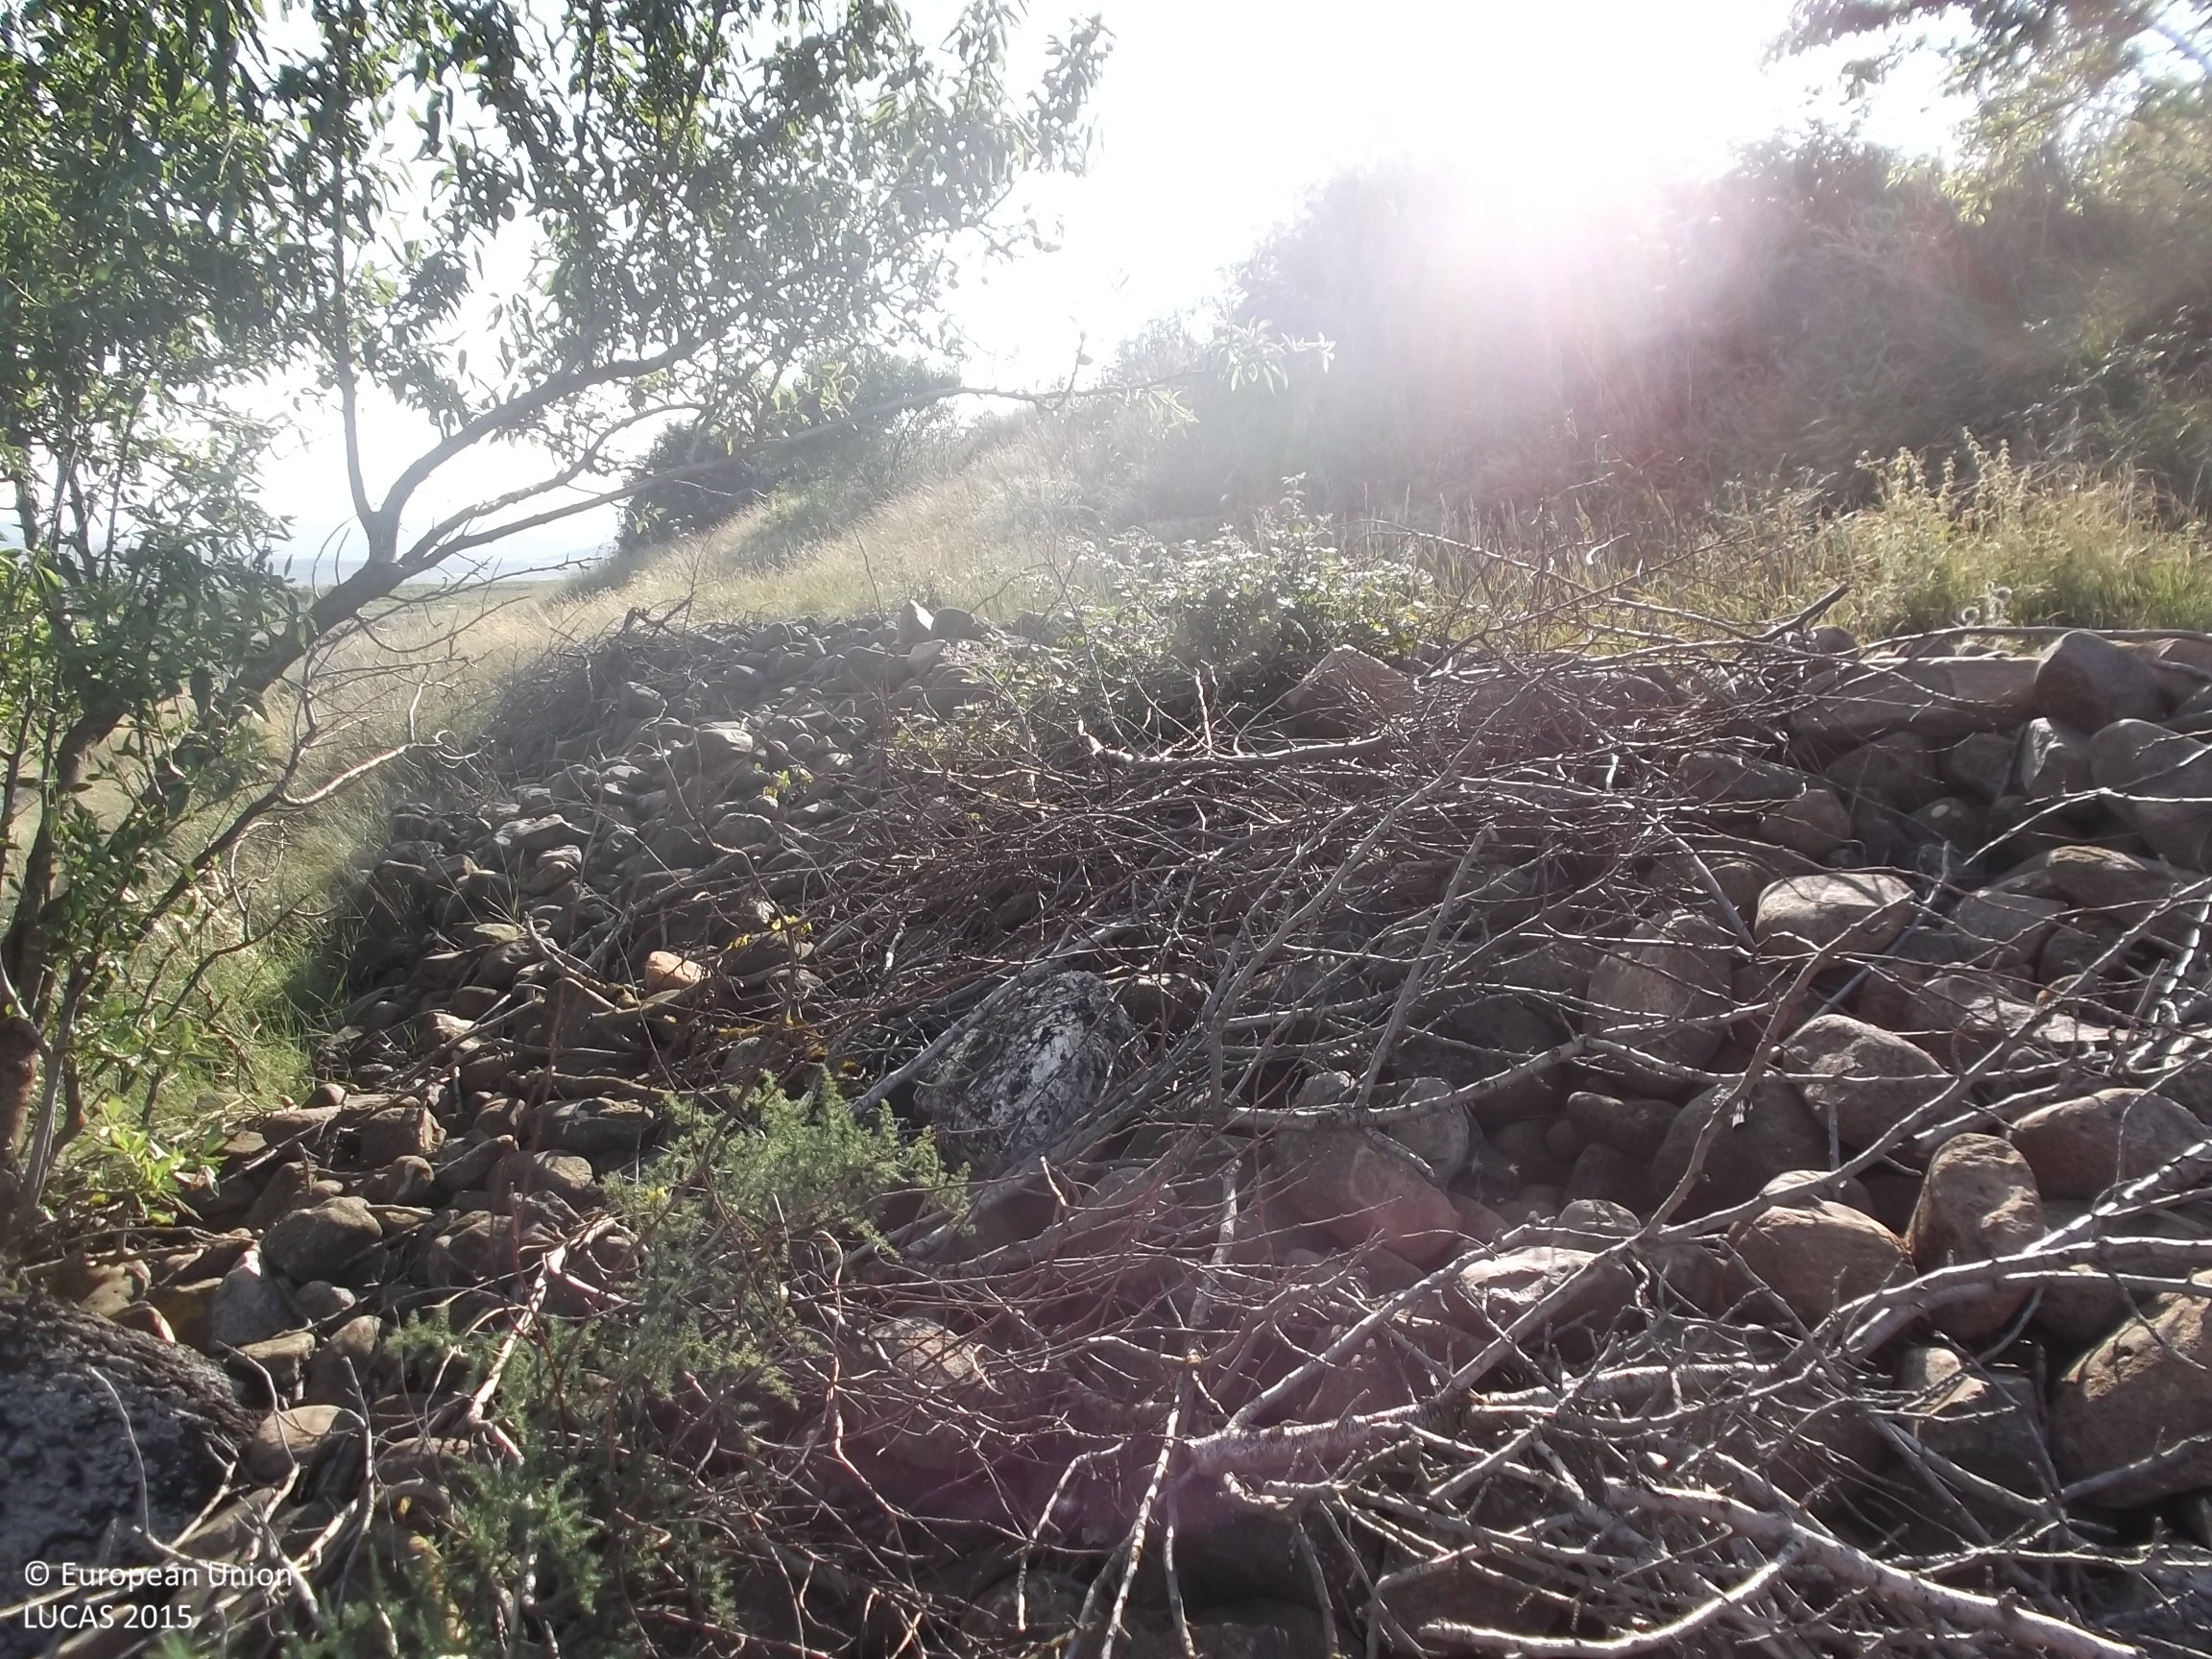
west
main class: Grassland
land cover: Grassland with sparse tree/shrub cover
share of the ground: 50 - 75 %
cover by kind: herbaceous plants 70 %, unconsolidated bare surface 25 %, broadleaved forest trees 5 %
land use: Semi-natural and natural areas not in use
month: June
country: ES
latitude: 42.3581
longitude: -2.1450
